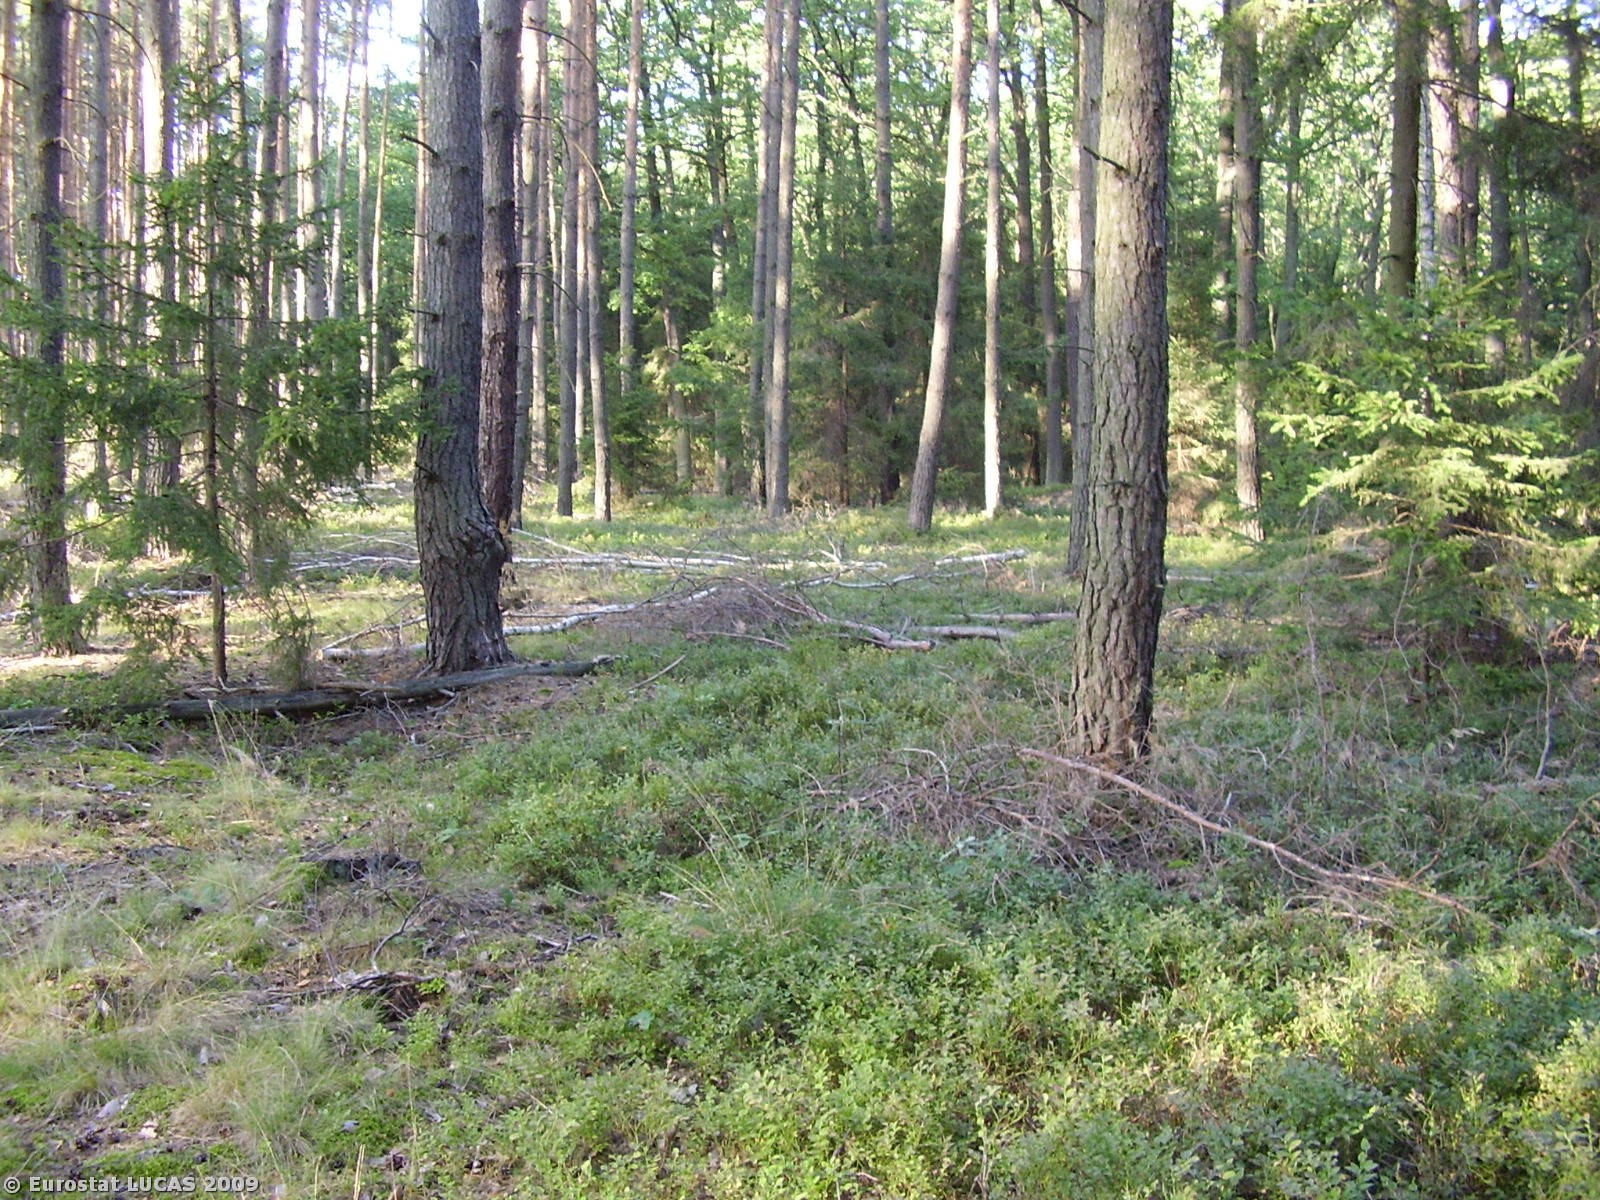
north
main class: Woodland
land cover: Mixed woodland
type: hemiboreal forest and nemoral coniferous forest and mixed broadleaved-coniferous forest
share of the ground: > 75 %
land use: Forestry
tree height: > 5 m
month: September
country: PL
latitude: 51.8857
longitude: 16.2978
